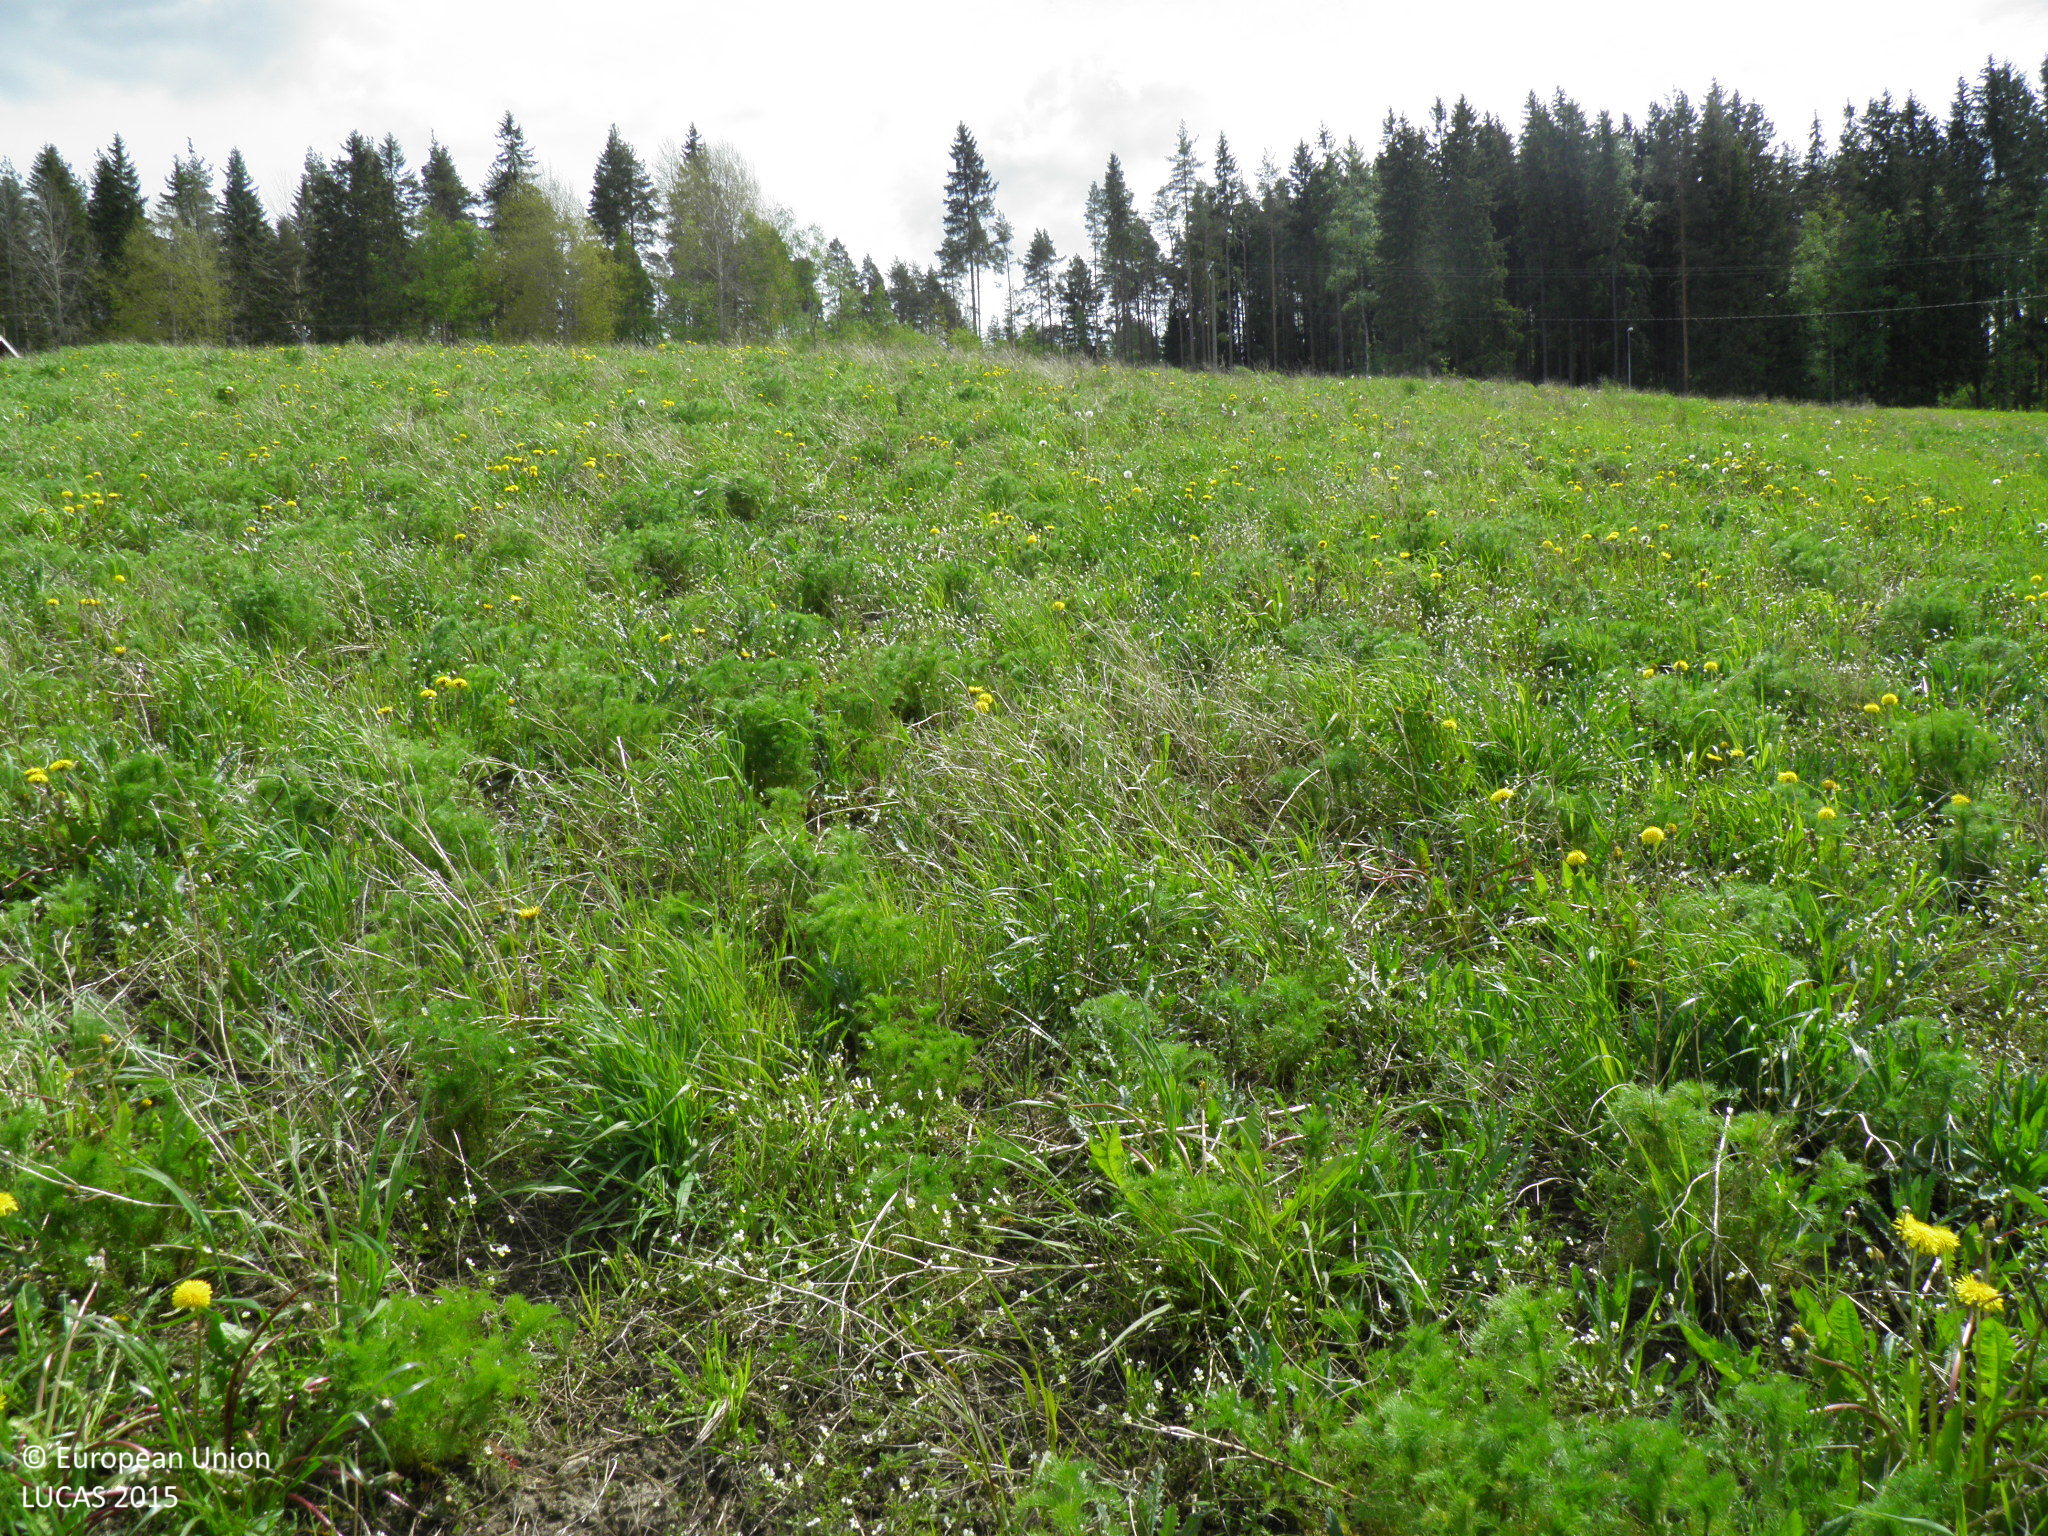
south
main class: Grassland
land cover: Grassland without tree/shrub cover
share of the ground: > 75 %
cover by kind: herbaceous plants 100 %
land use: Abandoned areas
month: June
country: FI
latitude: 60.4614
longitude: 22.7115
